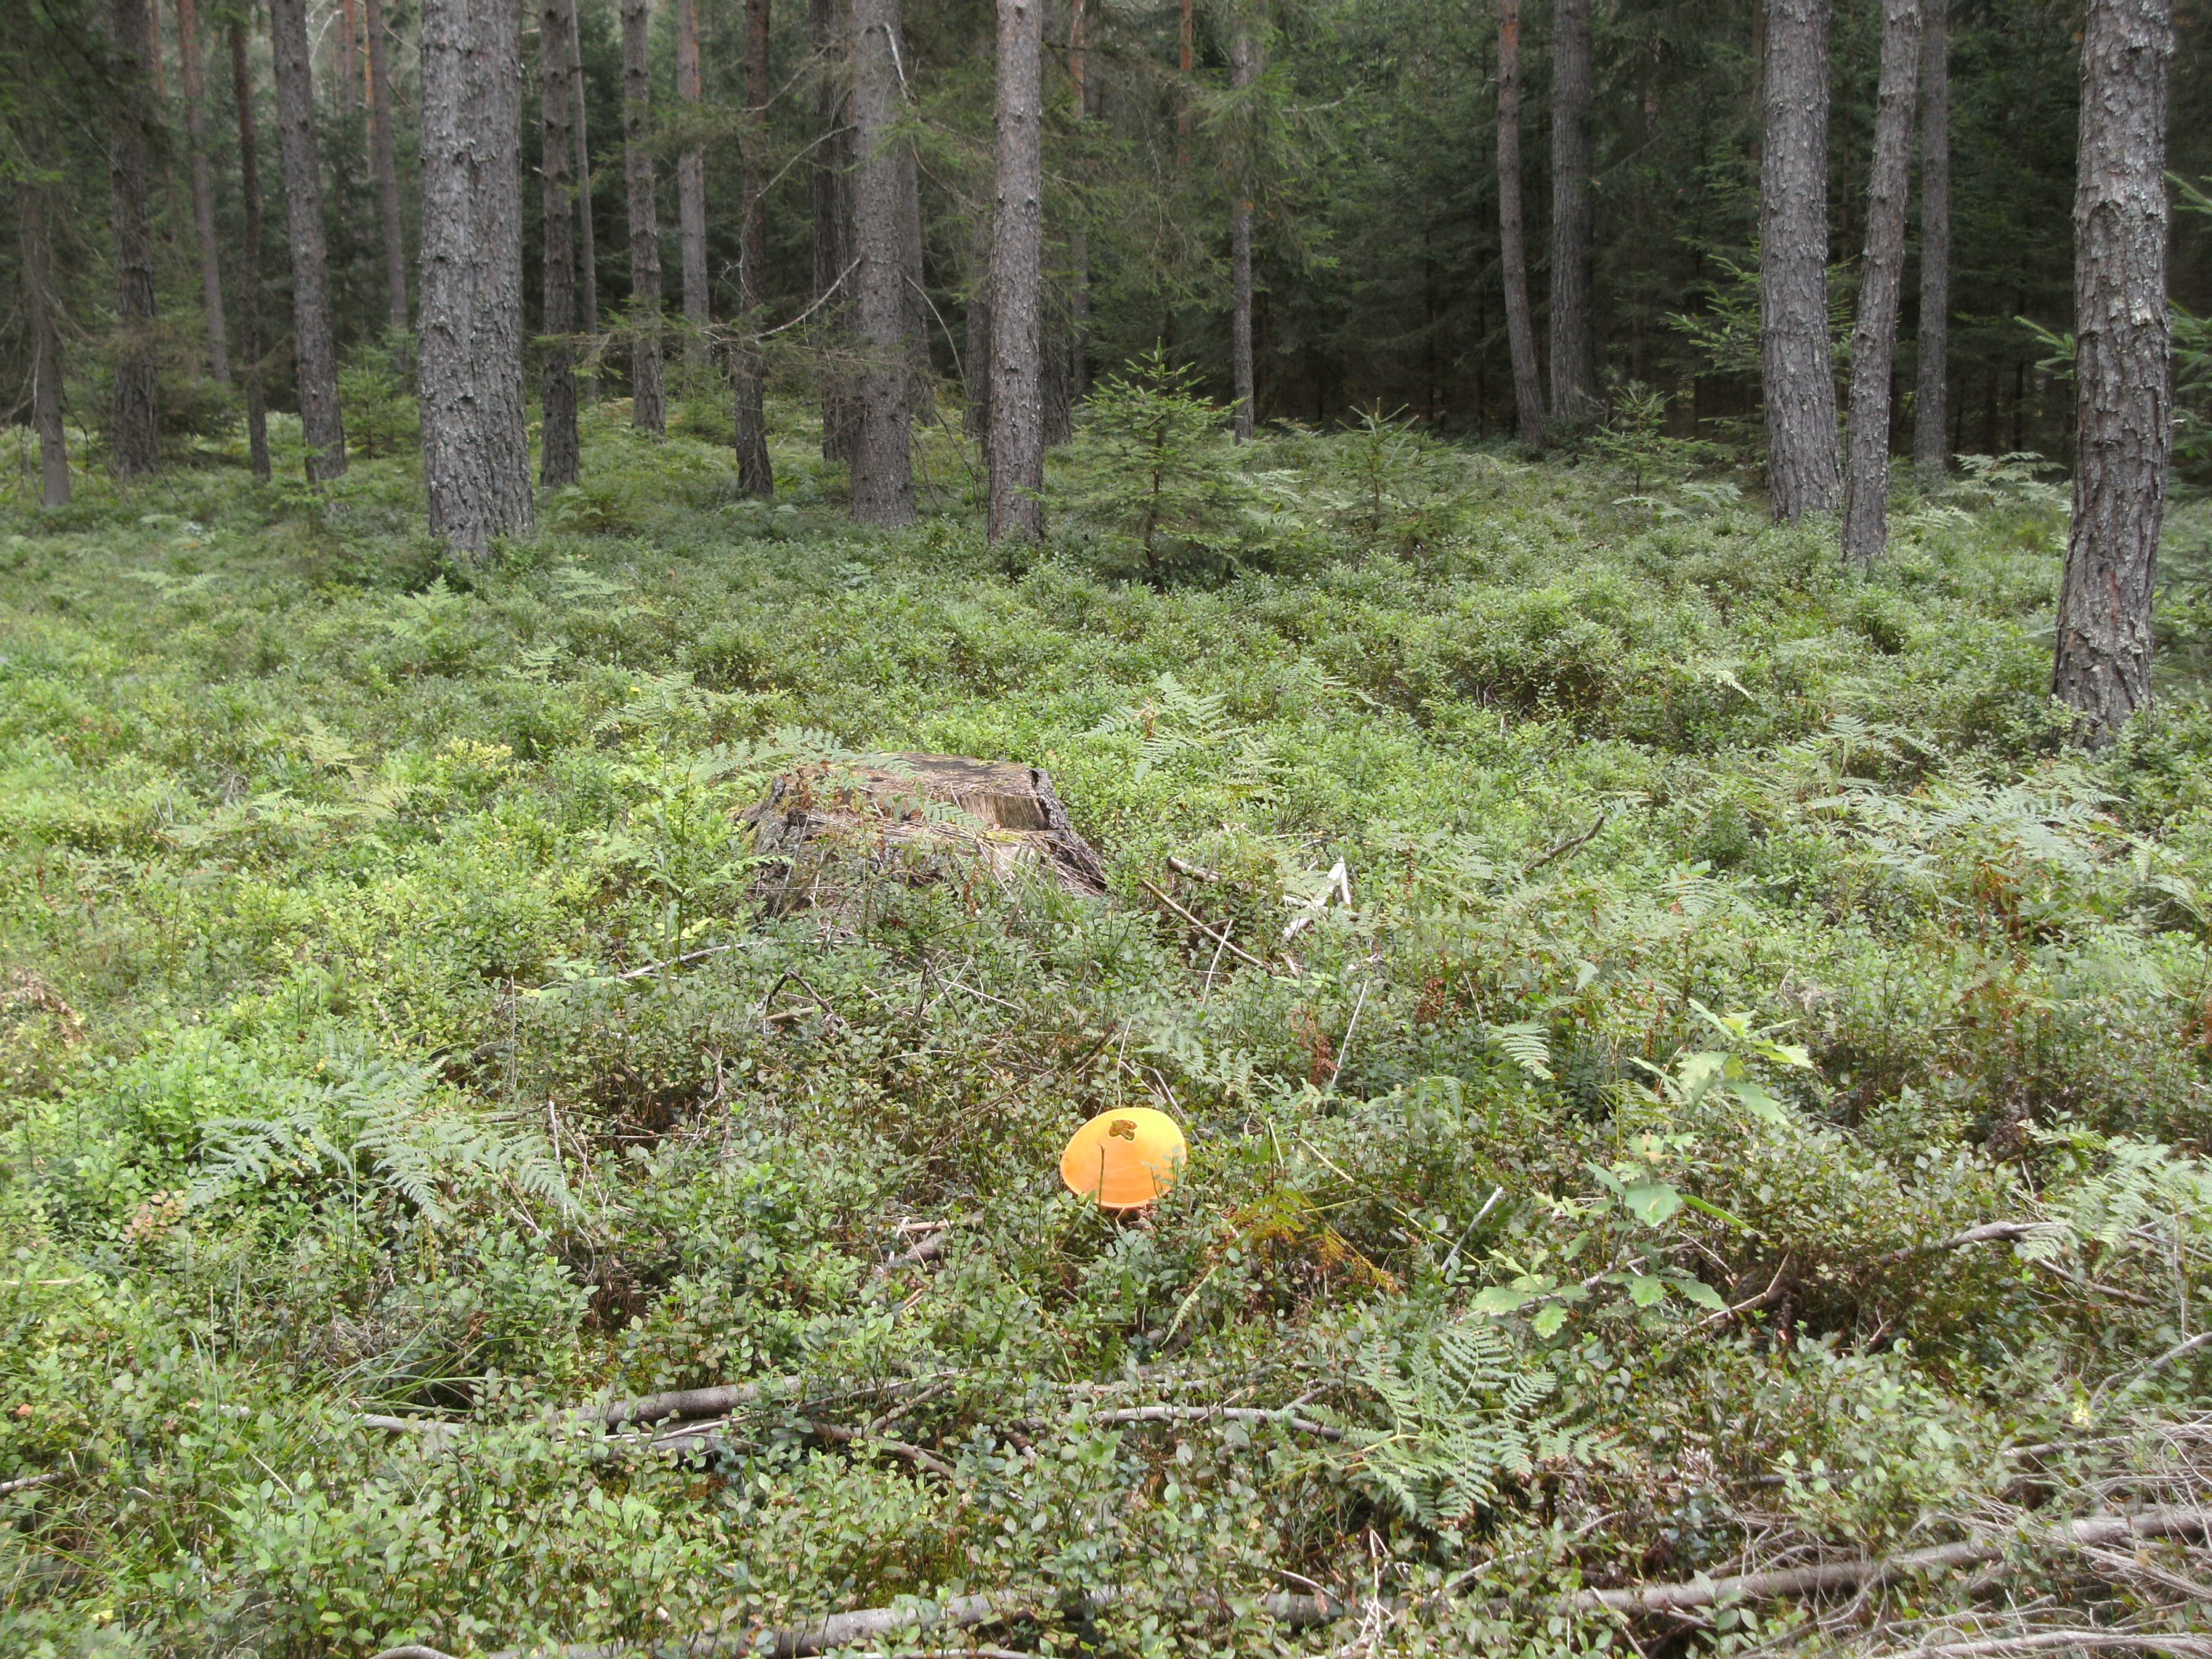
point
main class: Woodland
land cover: Pine dominated coniferous woodland
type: hemiboreal forest and nemoral coniferous forest and mixed broadleaved-coniferous forest
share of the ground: 25 - 50 %
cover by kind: shrubs 50 %, coniferous forest trees 40 %, herbaceous plants 5 %, lichens and mosses 5 %
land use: Forestry
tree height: > 5 m
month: July
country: AT
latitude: 46.5914
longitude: 14.6834
